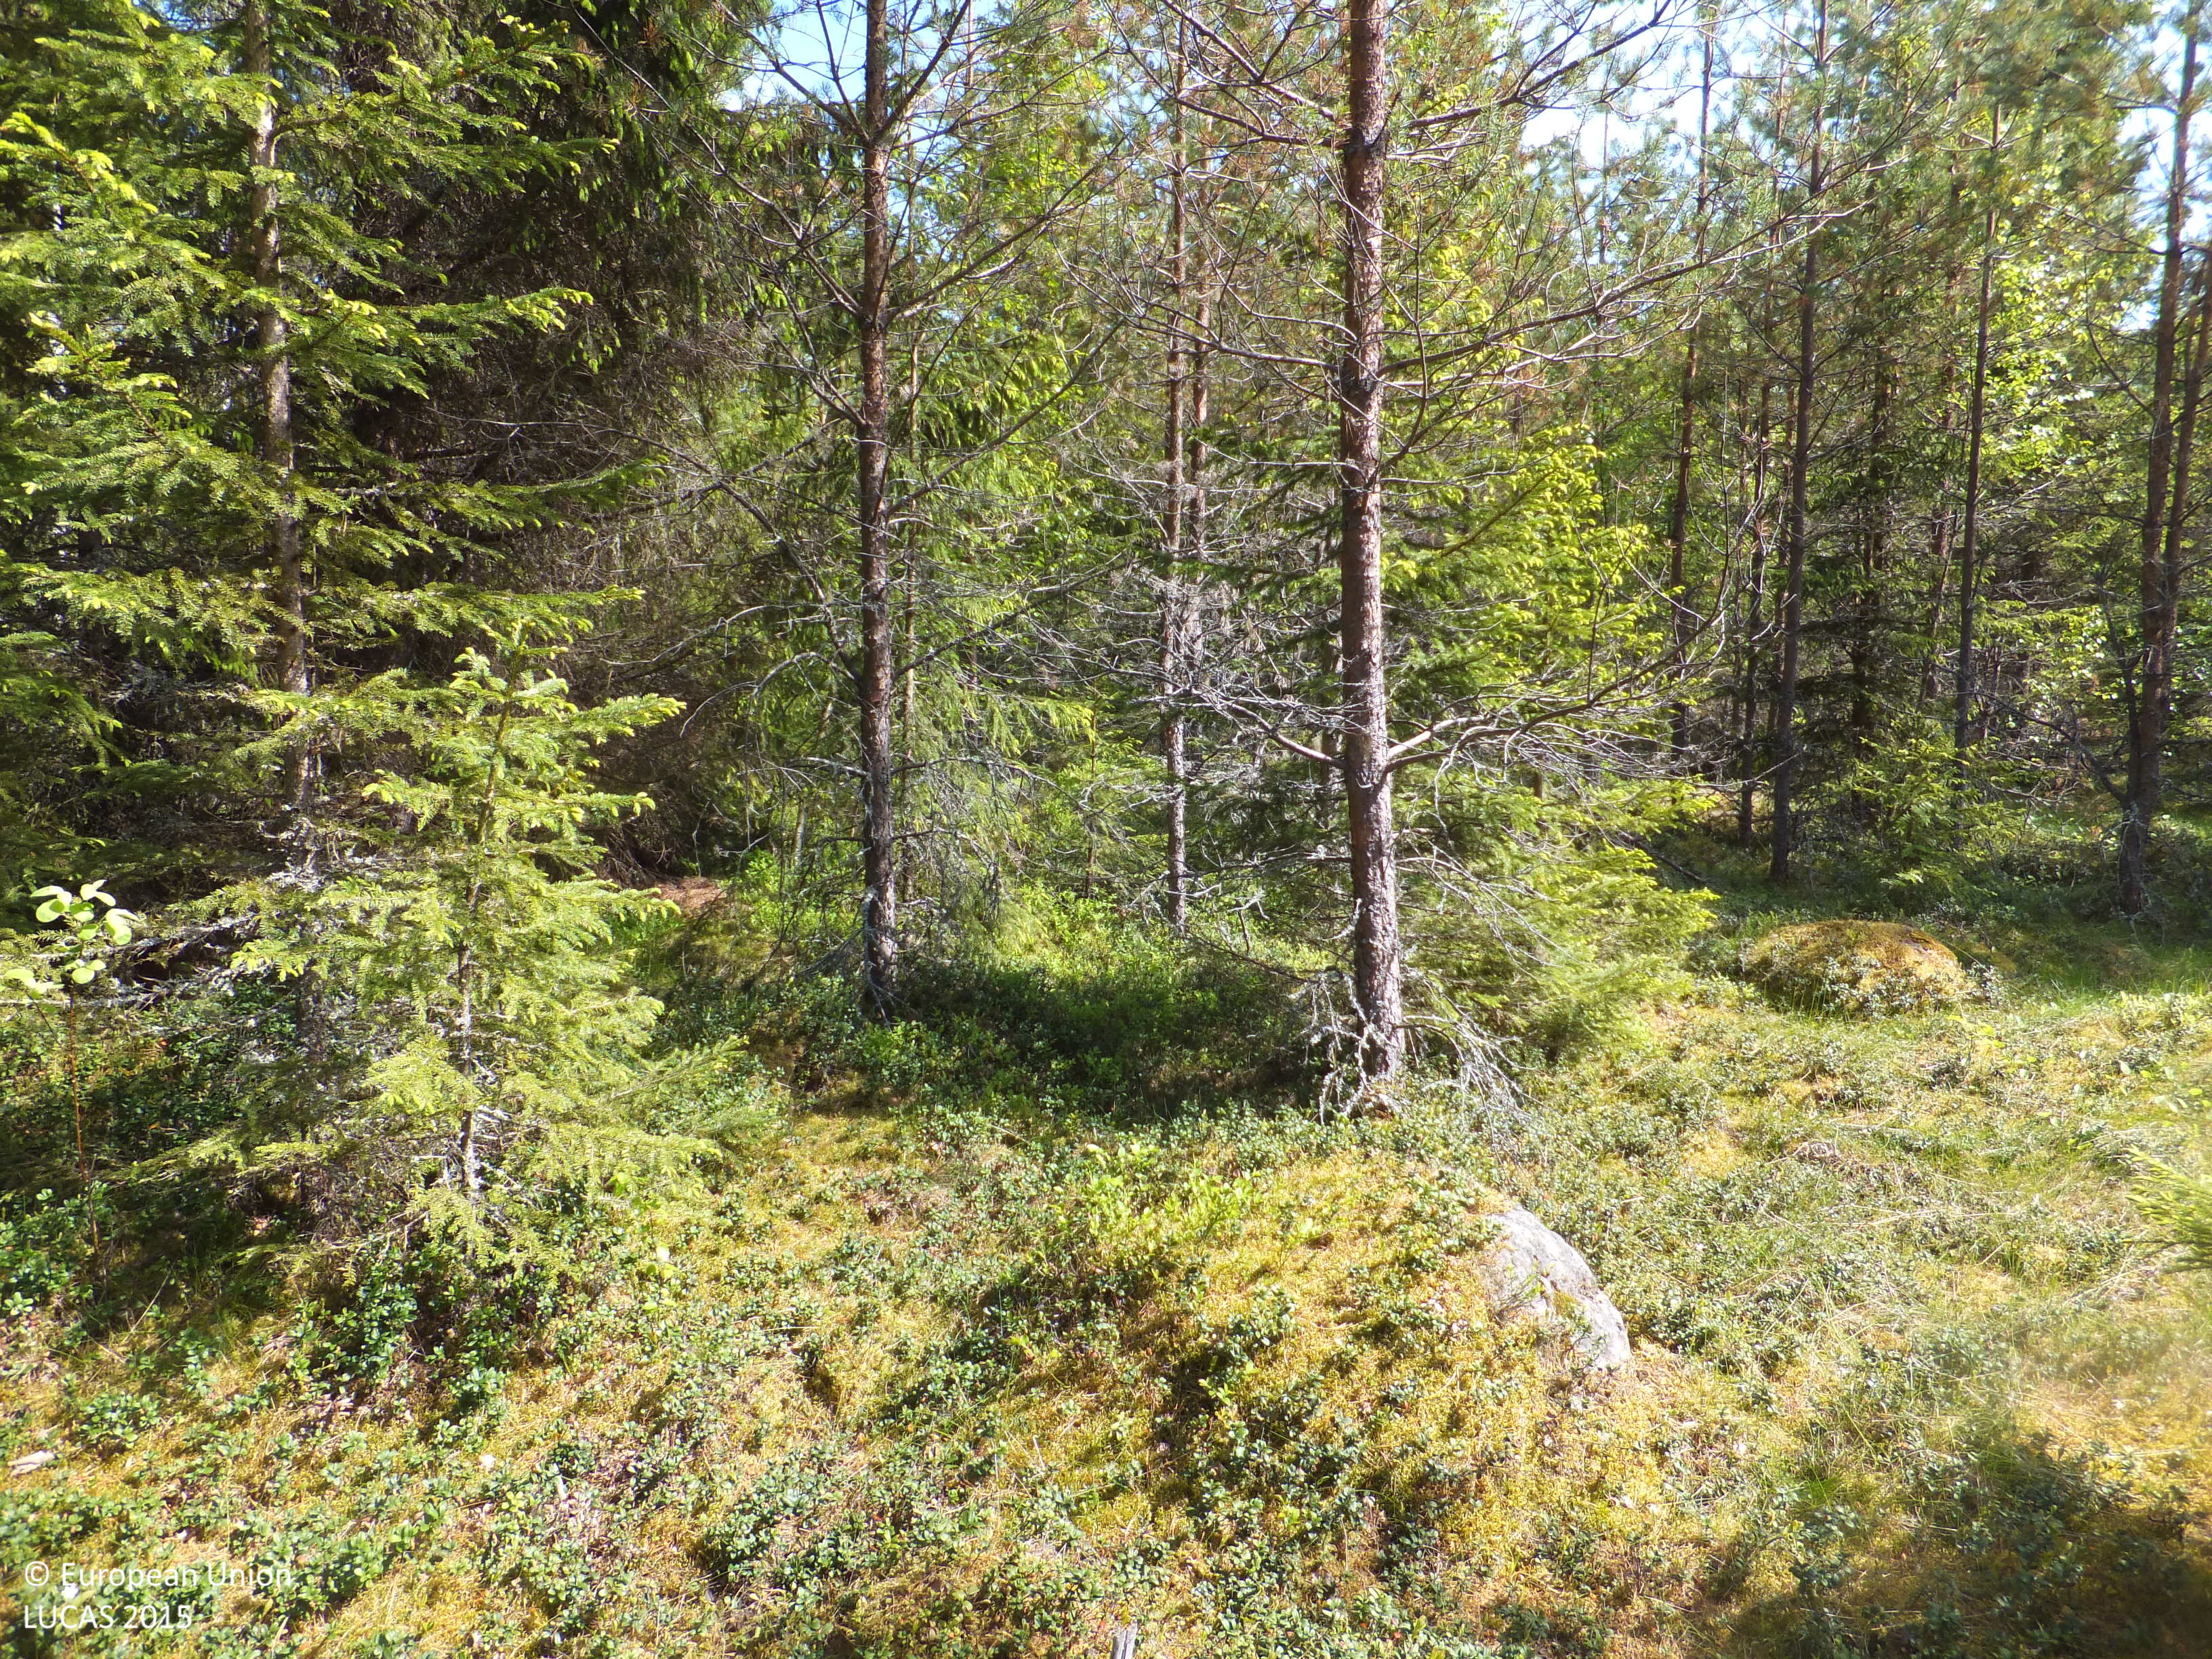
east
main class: Woodland
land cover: Pine dominated coniferous woodland
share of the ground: > 75 %
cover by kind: coniferous forest trees 80 %, broadleaved forest trees 10 %, shrubs 5 %, lichens and mosses 5 %
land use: Forestry
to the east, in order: Pine dominated coniferous woodland; Pine dominated mixed woodland; Spruce dominated mixed woodland; Ditches and canals; Spruce dominated mixed woodland
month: June
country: FI
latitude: 63.2928
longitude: 22.5544
